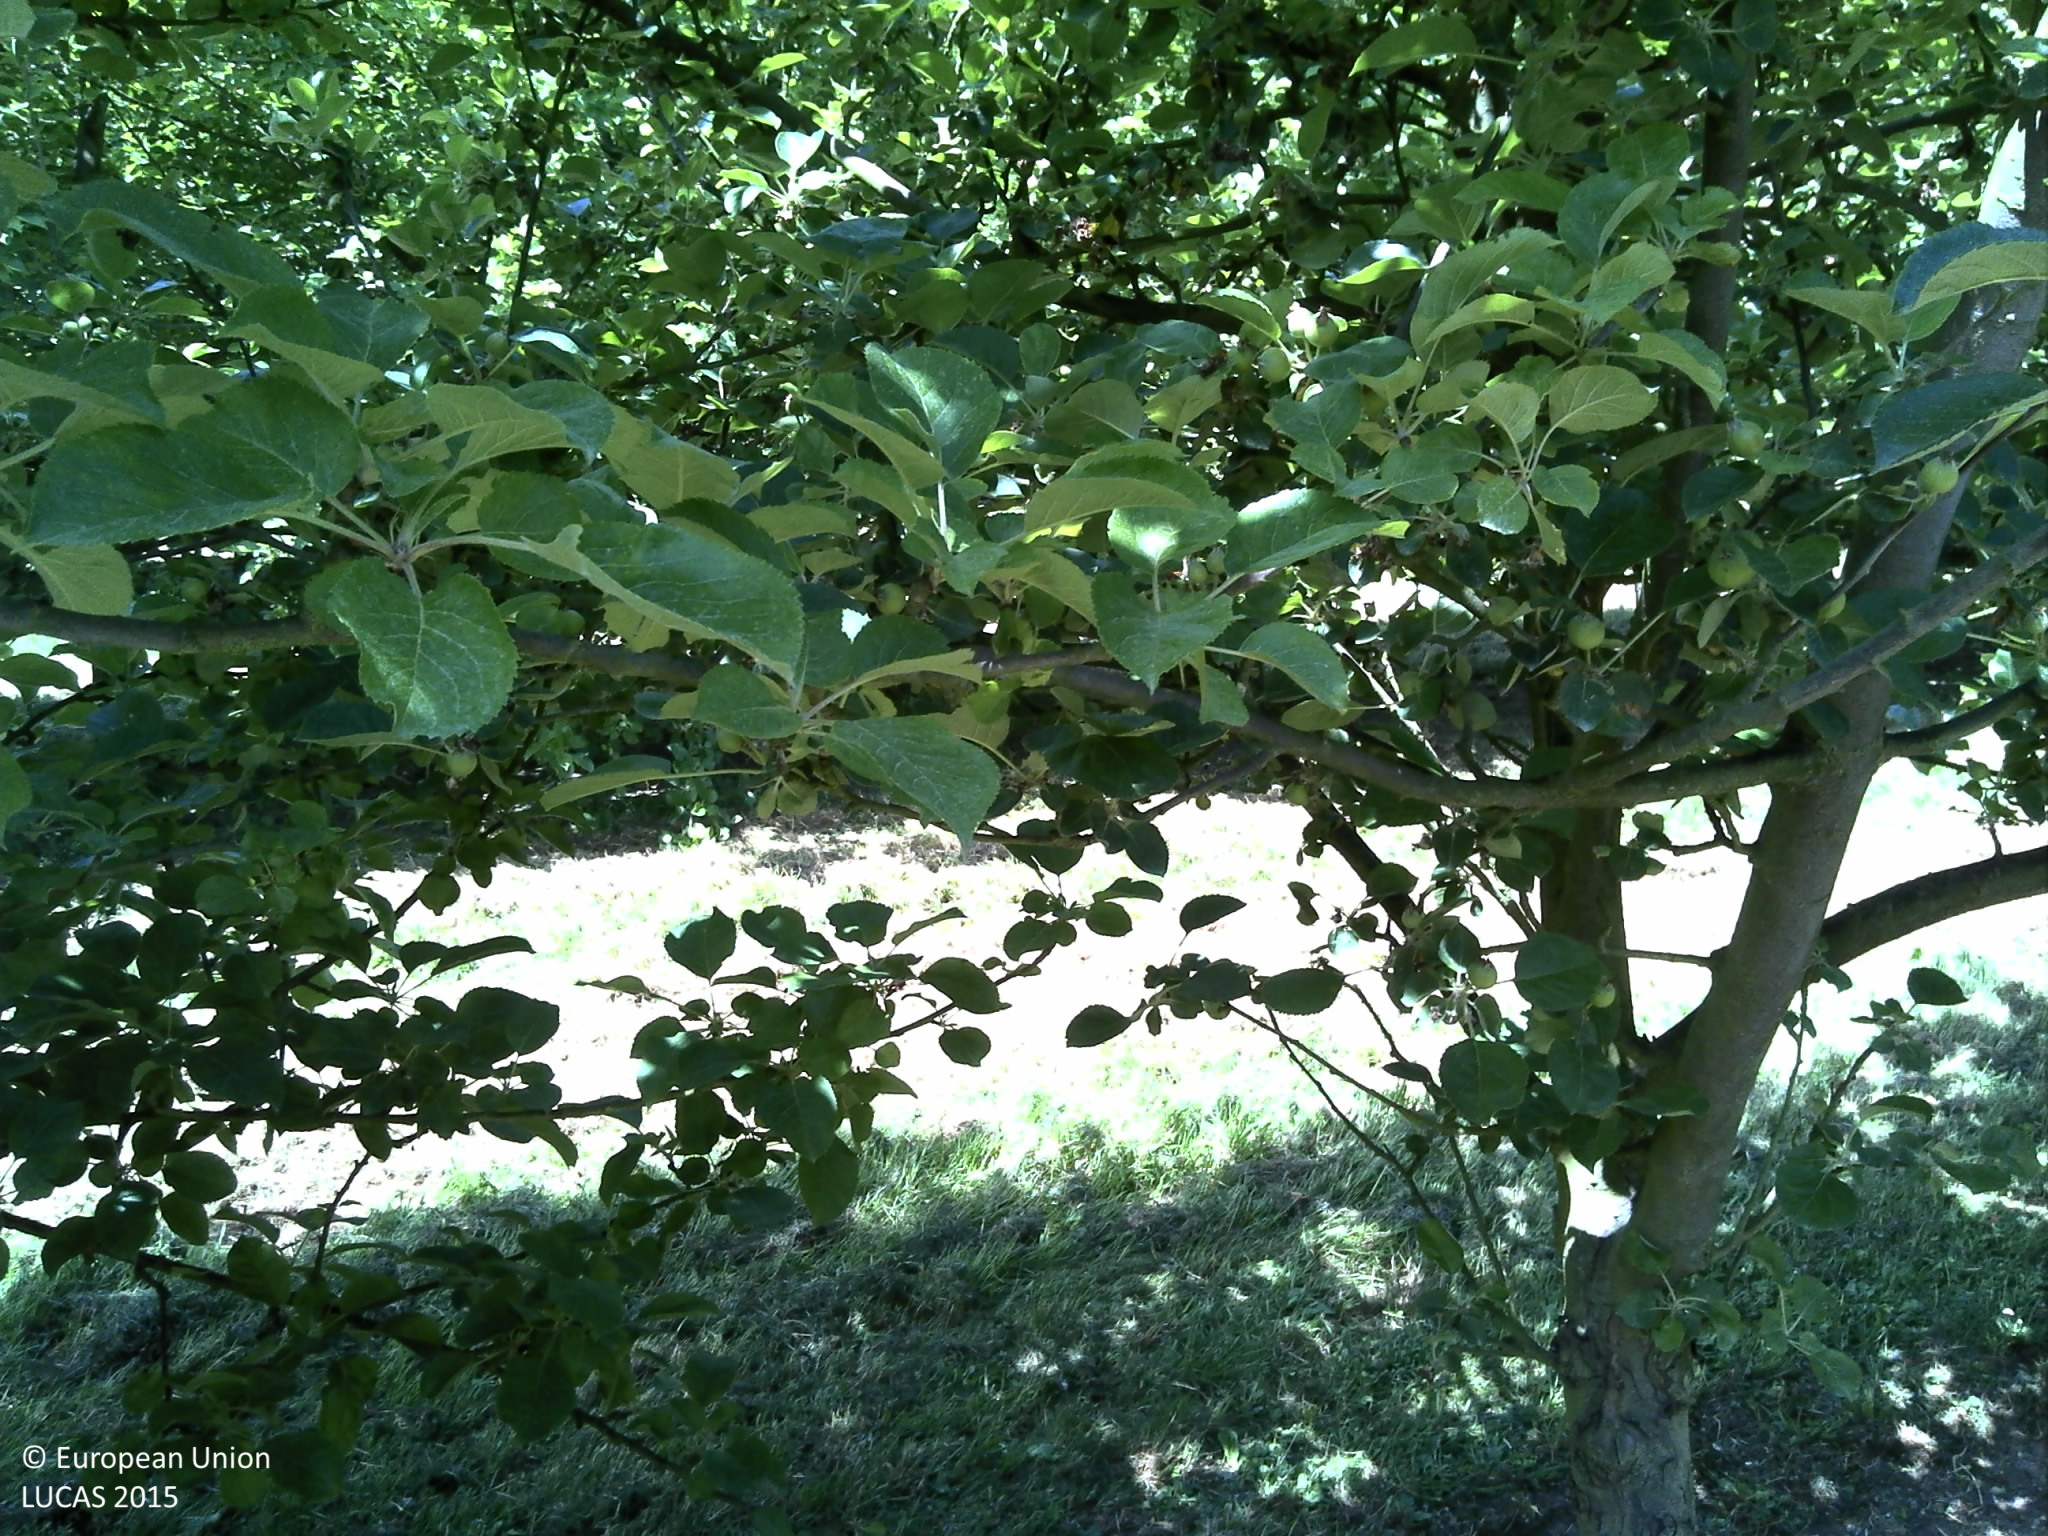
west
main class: Cropland
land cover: Apple fruit
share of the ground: 50 - 75 %
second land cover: Grassland without tree/shrub cover
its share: 50 - 75 %
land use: Agriculture (excluding fallow land and kitchen gardens)
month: June
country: FR
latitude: 49.7816
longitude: 1.1037
